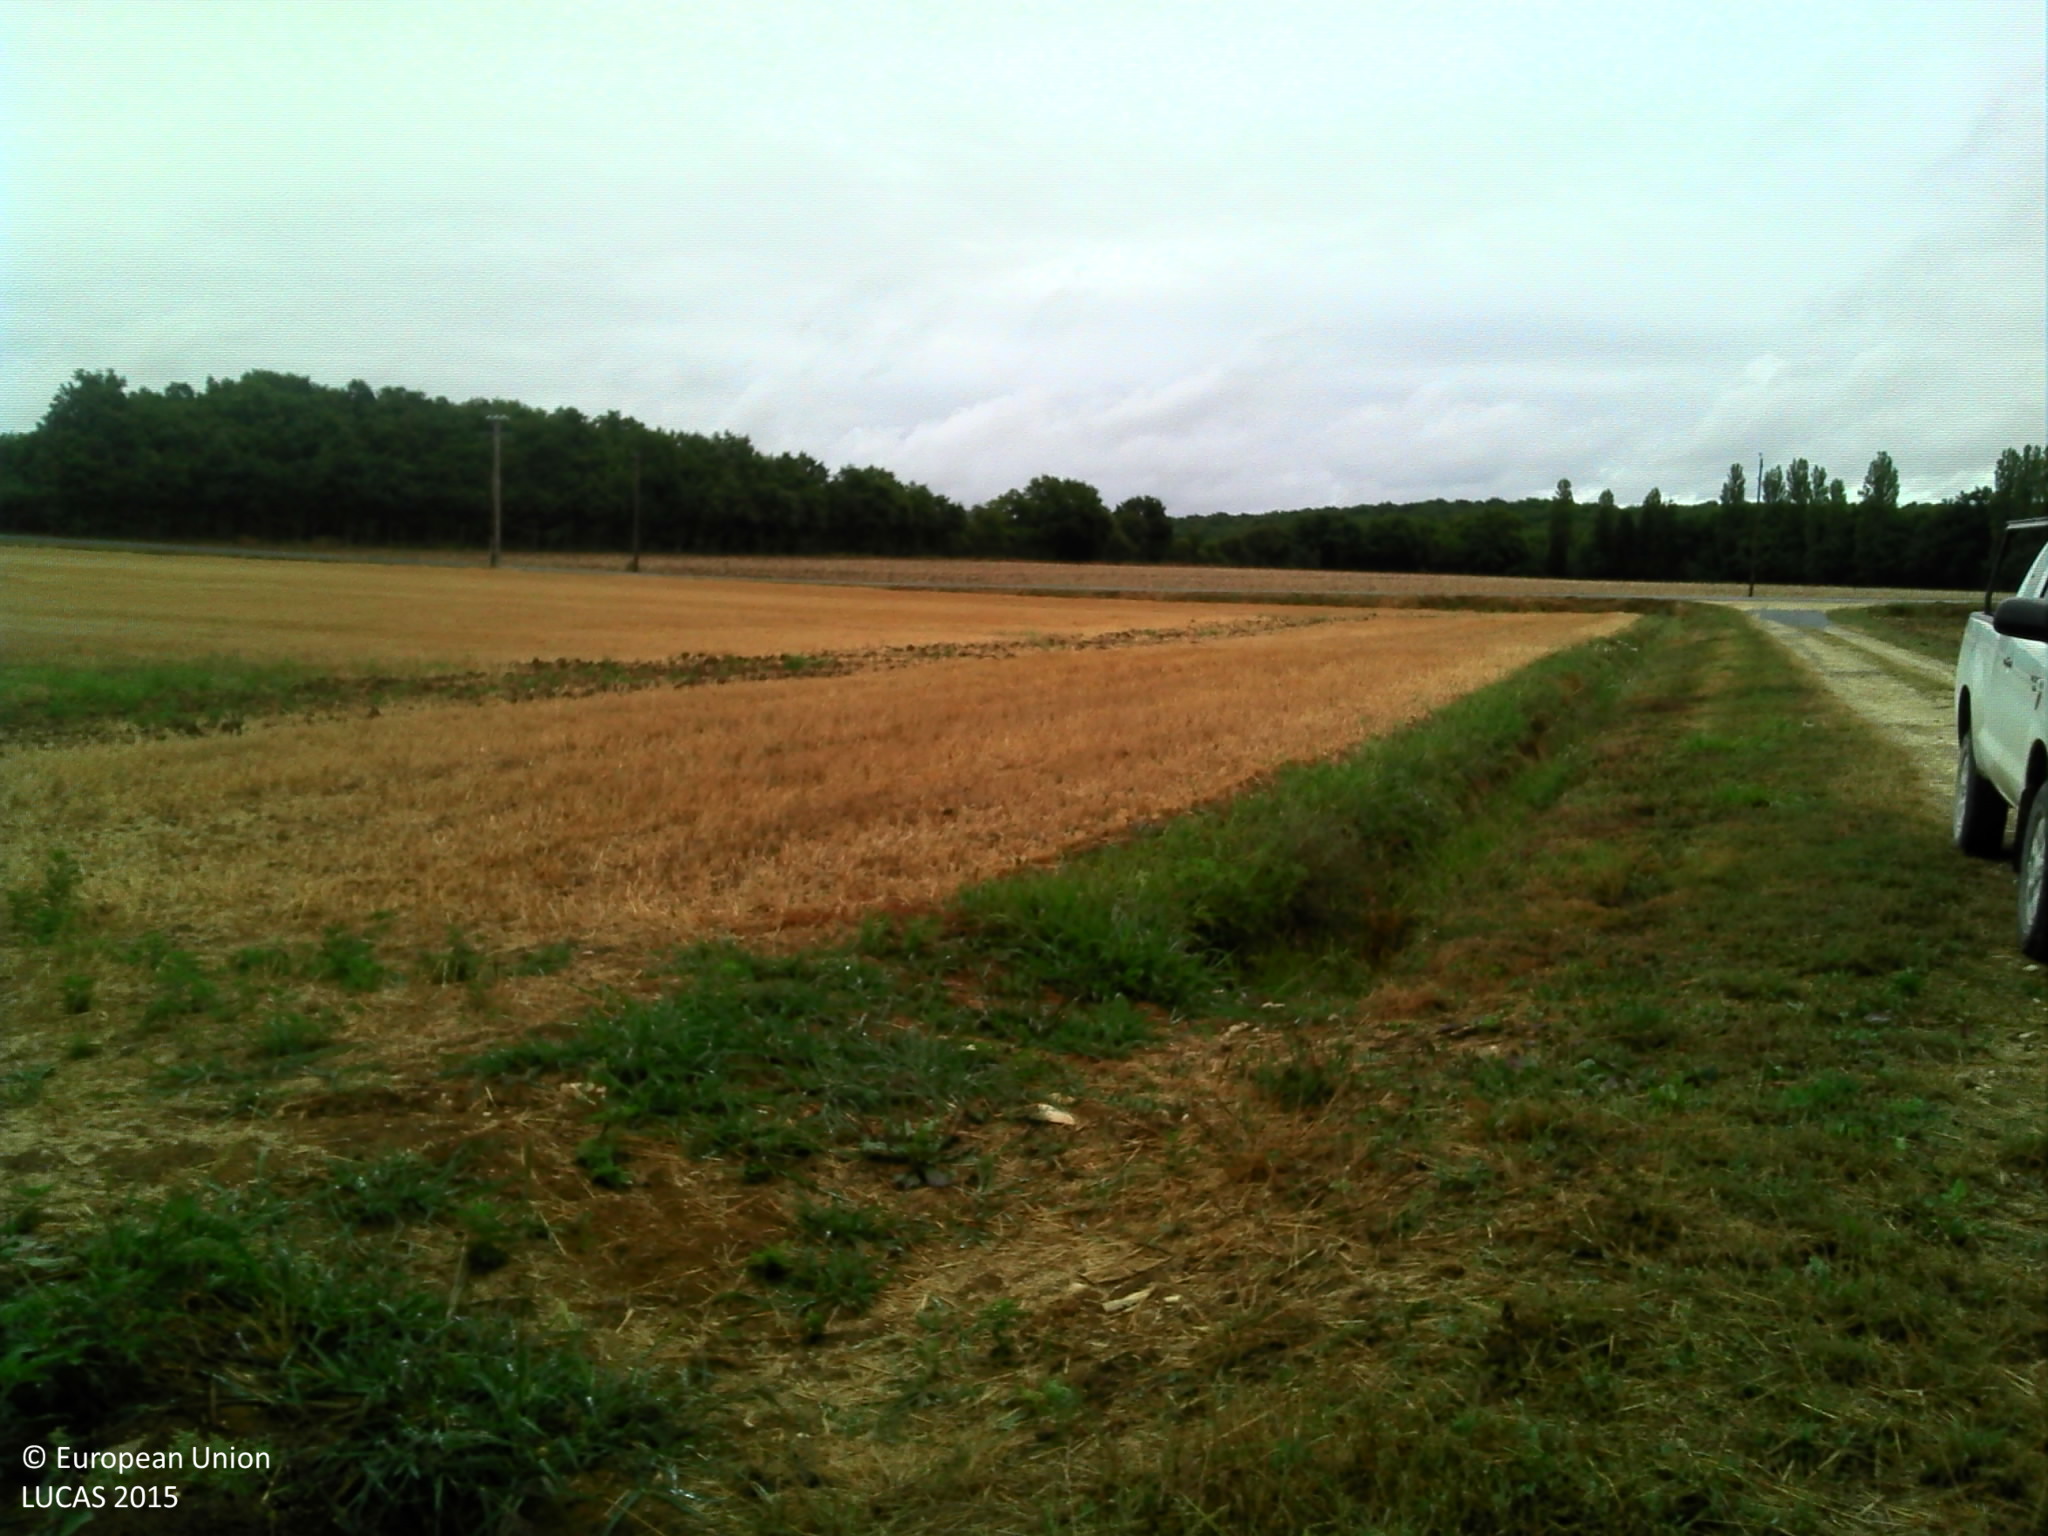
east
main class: Woodland
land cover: Broadleaved woodland
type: mesophytic deciduous forest
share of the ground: > 75 %
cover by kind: broadleaved forest trees 100 %
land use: Forestry
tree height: > 5 m
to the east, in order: Broadleaved woodland
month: July
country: FR
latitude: 46.8573
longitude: 2.1354
